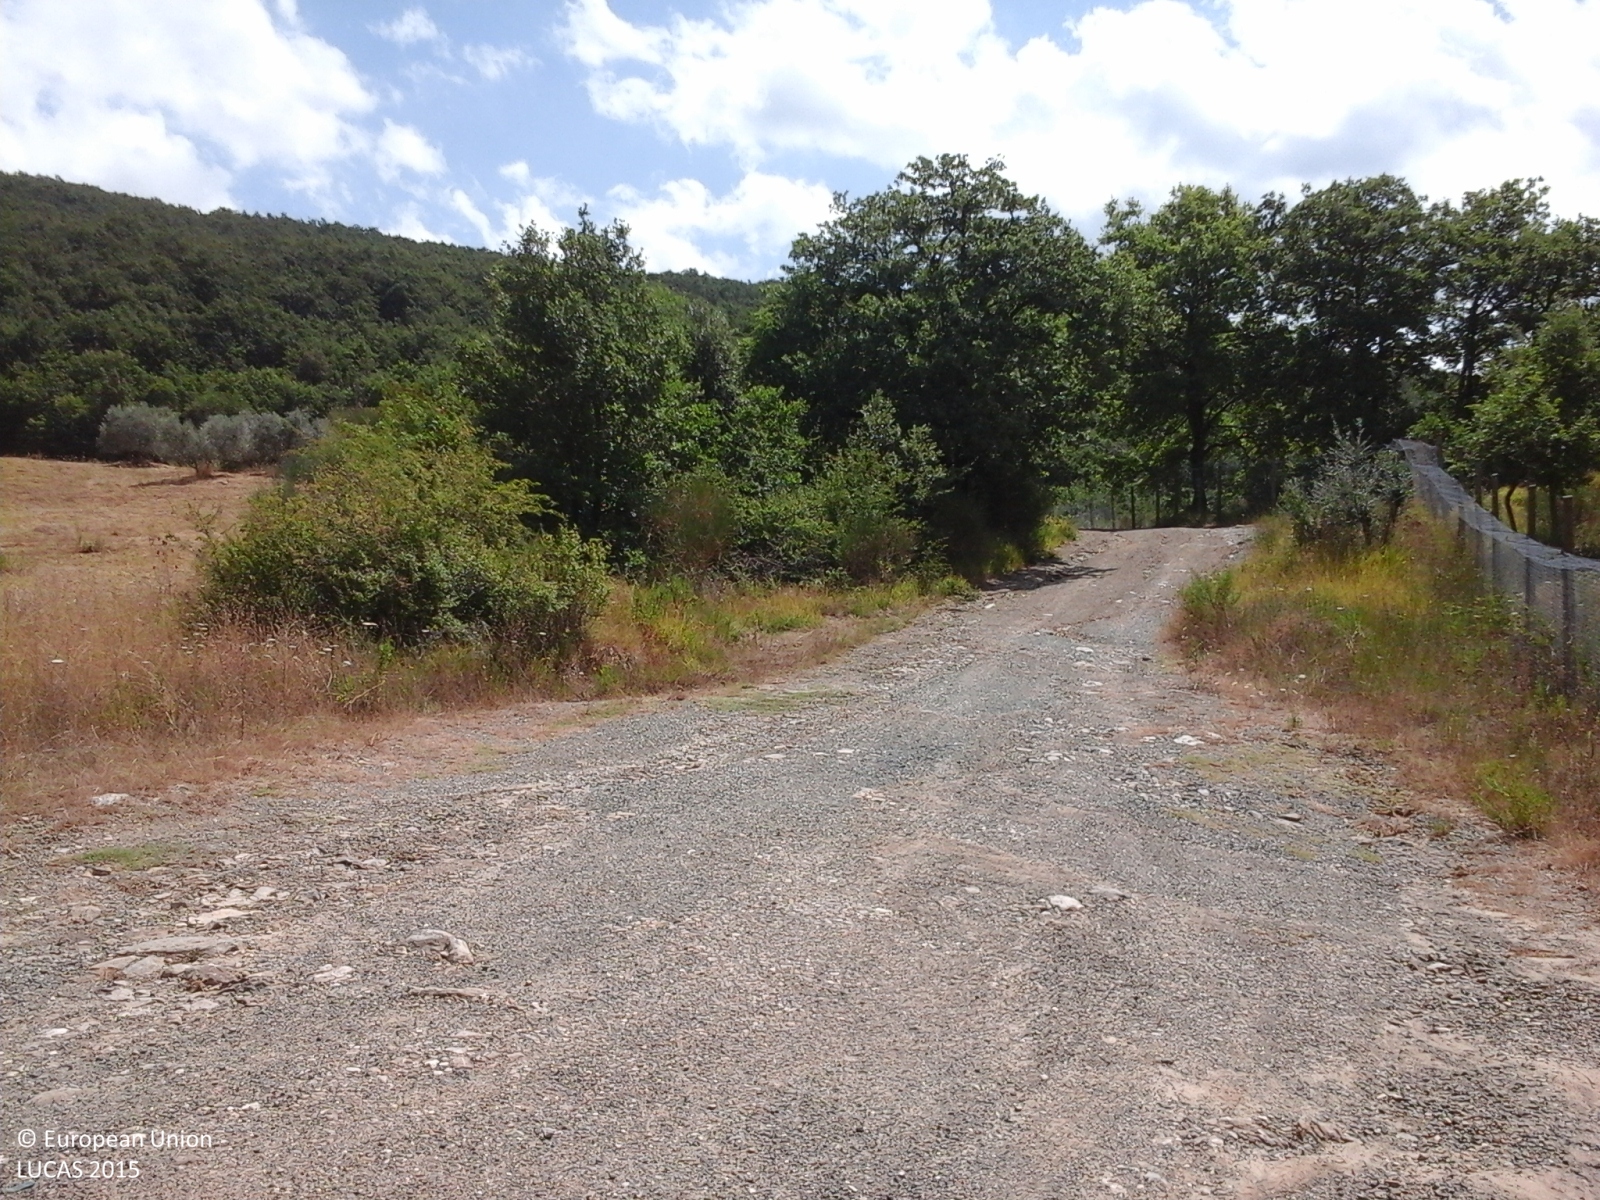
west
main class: Grassland
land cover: Grassland with sparse tree/shrub cover
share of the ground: > 75 %
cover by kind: herbaceous plants 85 %, shrubs 10 %, broadleaved forest trees 5 %
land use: Agriculture (excluding fallow land and kitchen gardens)
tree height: < 5 m
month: February
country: IT
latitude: 43.4443
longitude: 10.9241
